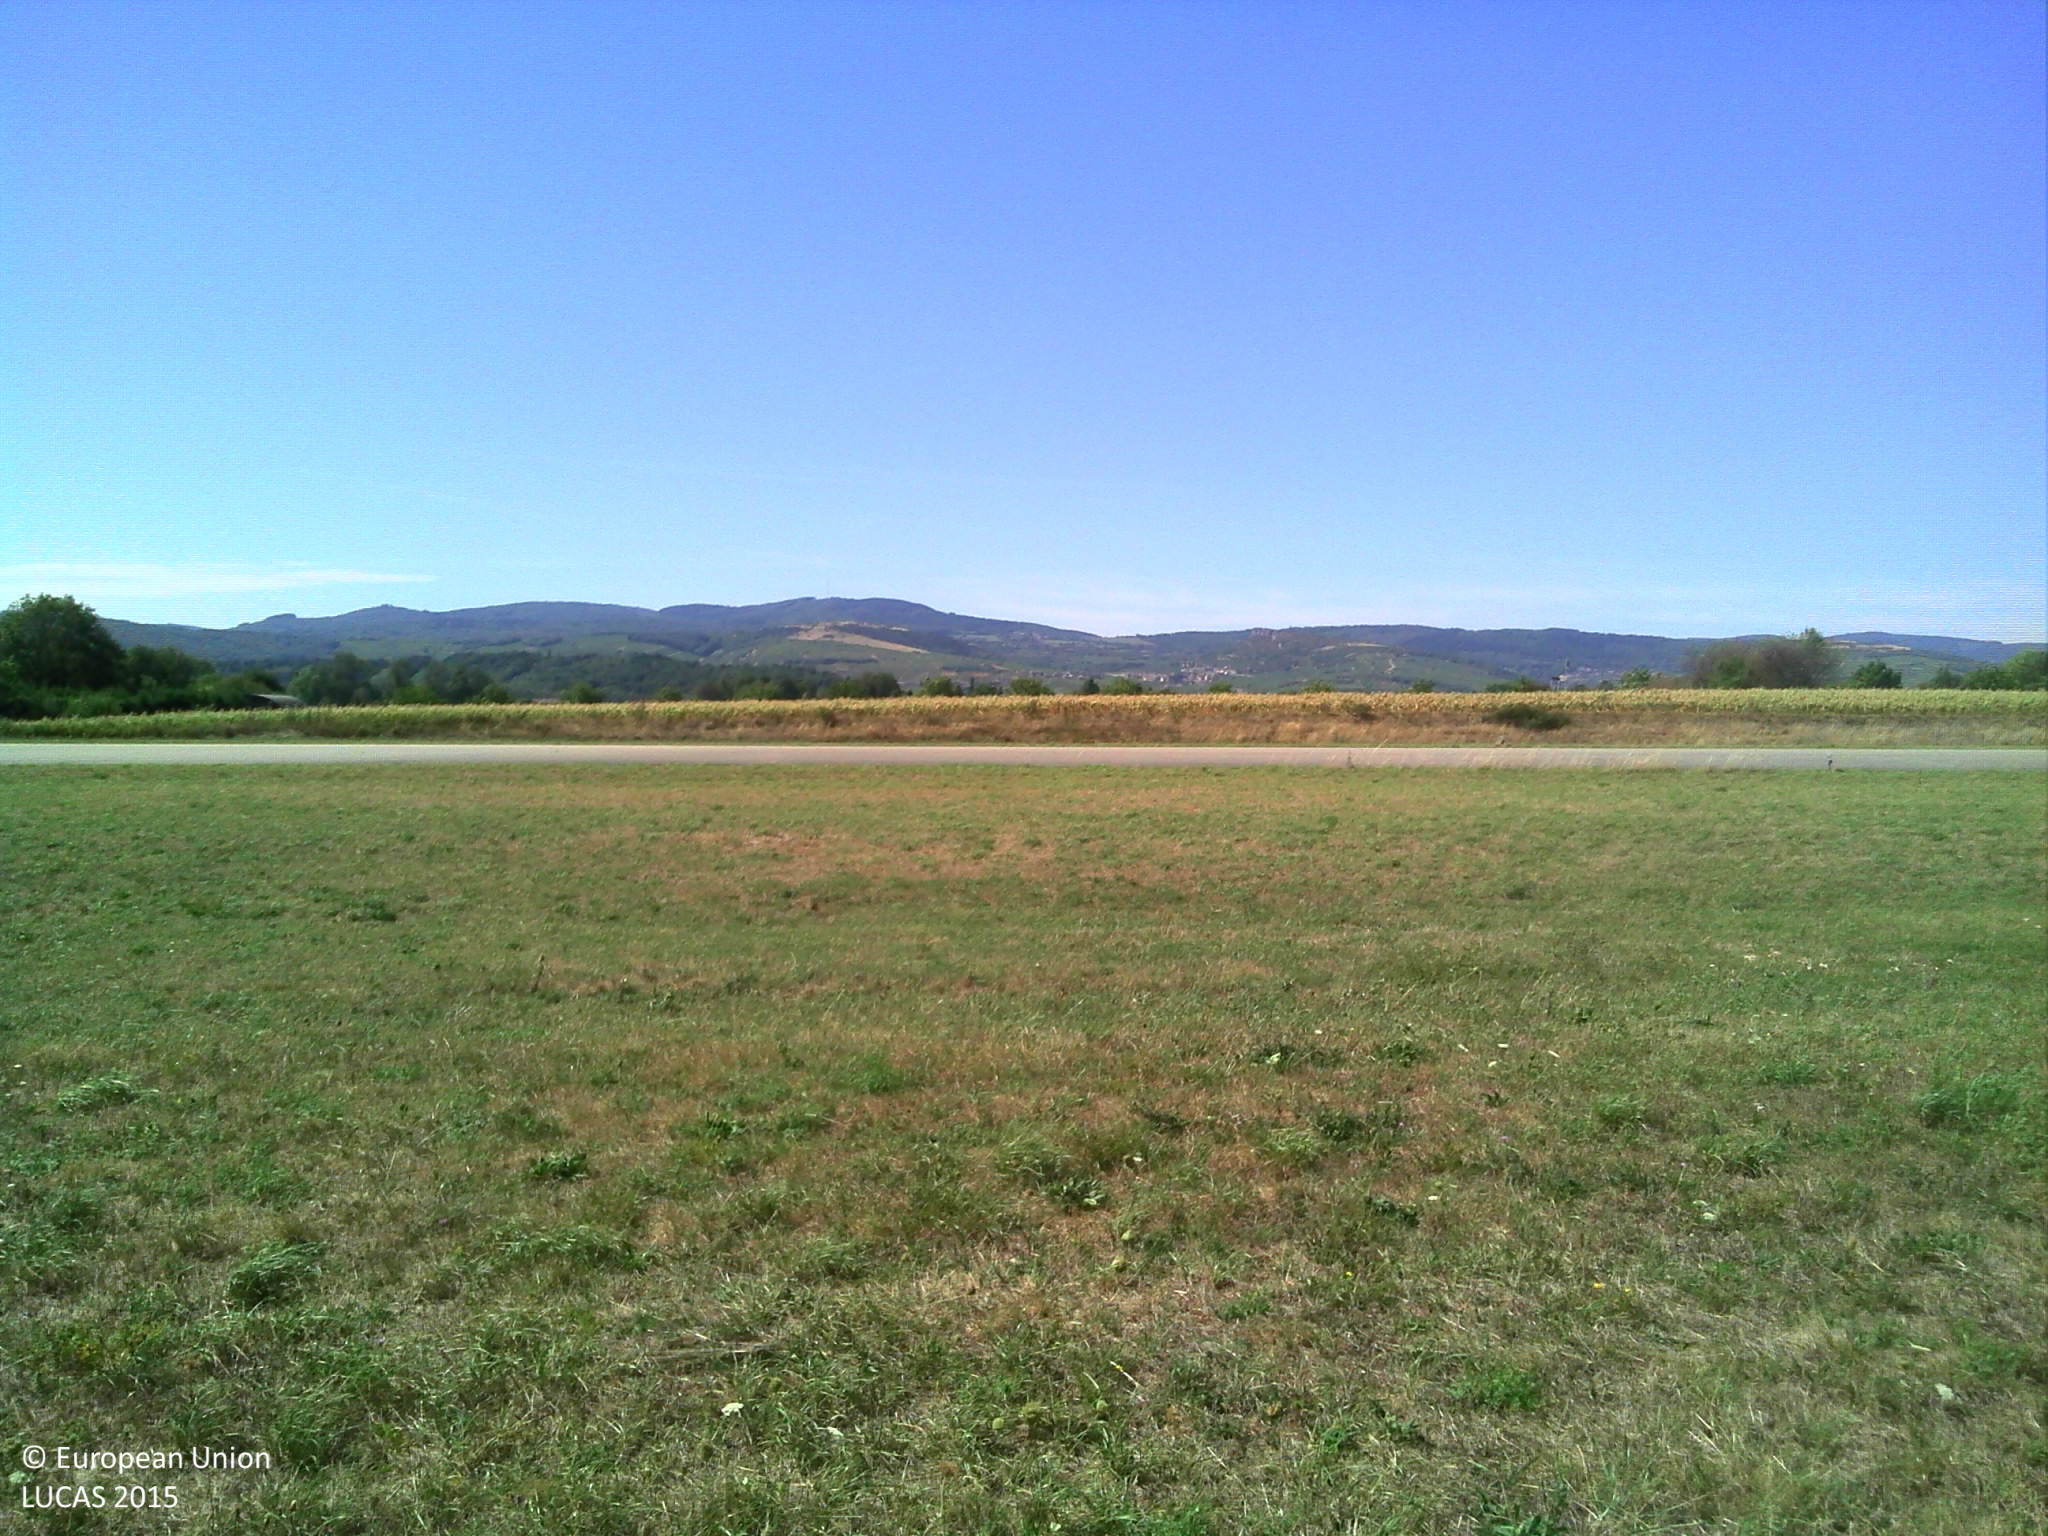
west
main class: Grassland
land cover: Grassland without tree/shrub cover
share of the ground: > 75 %
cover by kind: herbaceous plants 100 %
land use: Air transport
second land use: Agriculture (excluding fallow land and kitchen gardens)
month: August
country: FR
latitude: 46.2968
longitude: 4.7965
